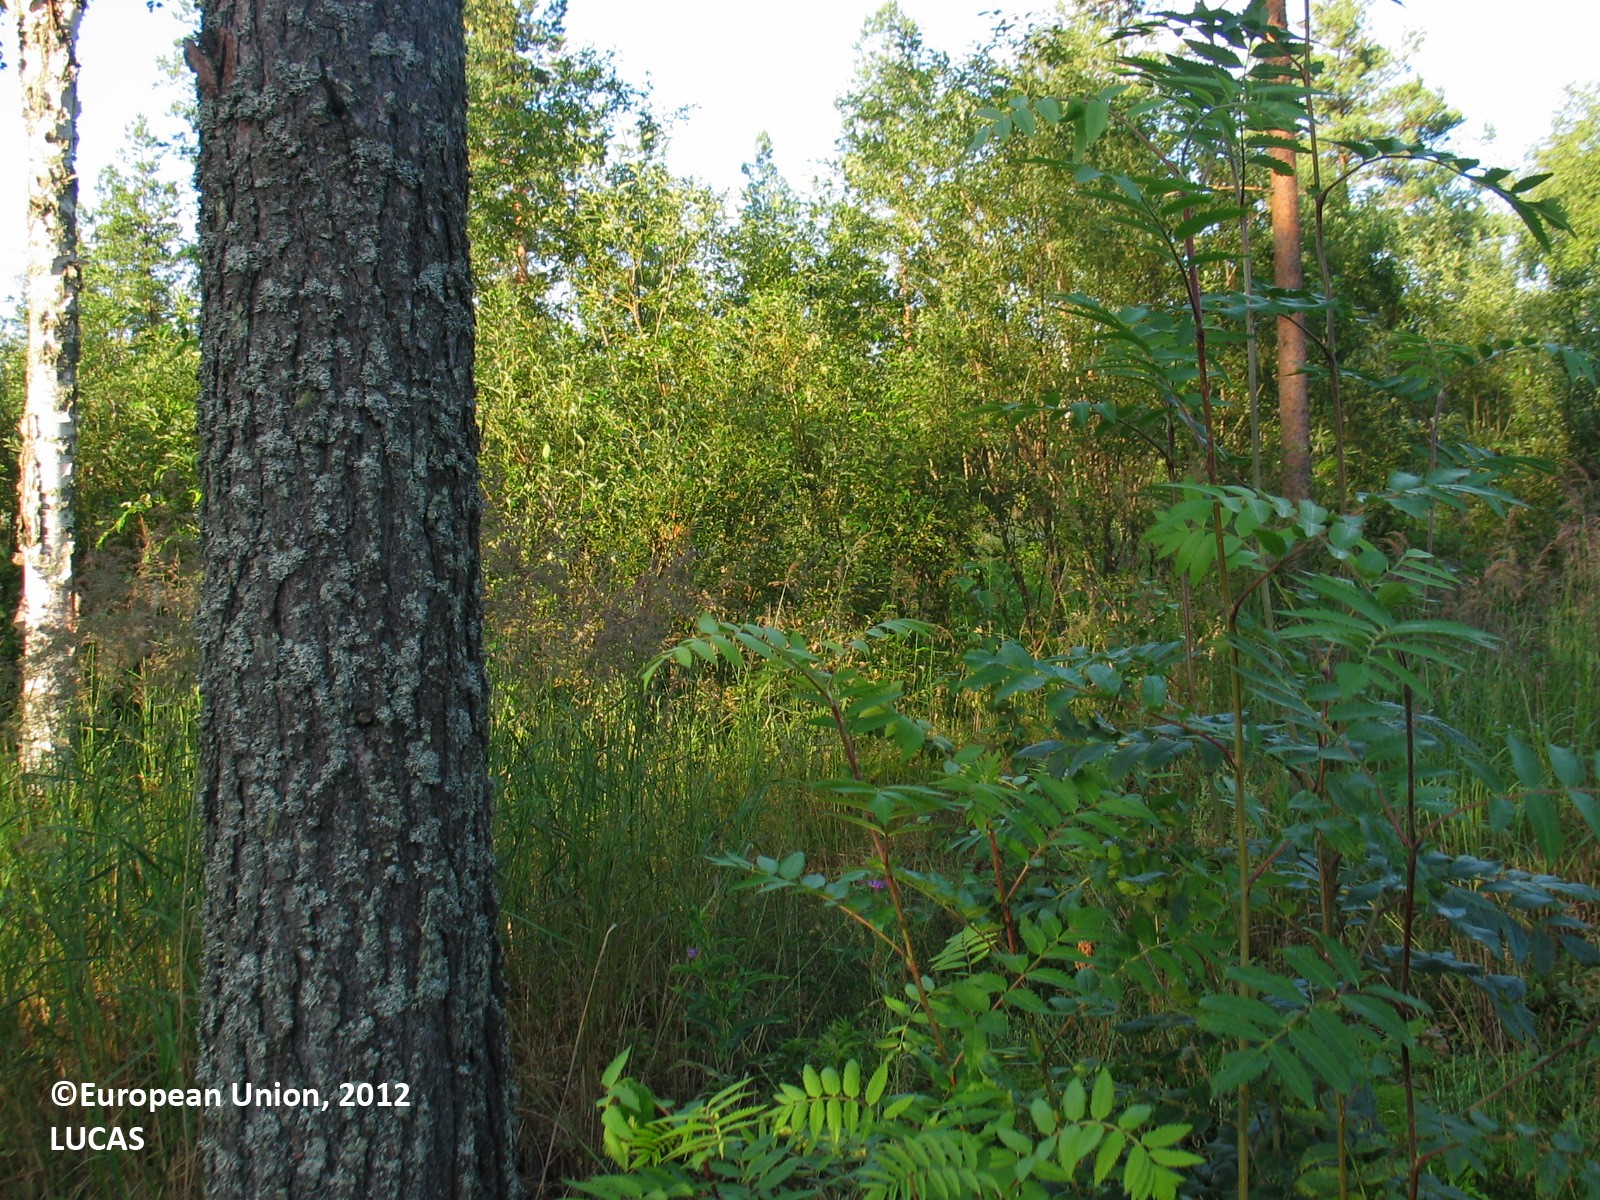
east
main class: Woodland
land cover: Other mixed woodland
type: boreal forest
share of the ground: 25 - 50 %
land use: Forestry
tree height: > 5 m
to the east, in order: Other mixed woodland; Abandoned hedges; Ditches and canals; Grassland without tree/shrub cover; Paved roads, cycling and walking lanes; Grassland without tree/shrub cover; Ditches and canals; Abandoned hedges; Other mixed woodland; Broadleaved woodland; Grassland with sparse tree/shrub cover; Ditches and canals; Grassland with sparse tree/shrub cover; Broadleaved woodland; Ditches and canals; Broadleaved woodland; Ditches and canals; Broadleaved woodland; Ditches and canals; Broadleaved woodland
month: July
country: FI
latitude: 64.7034
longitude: 26.4067
